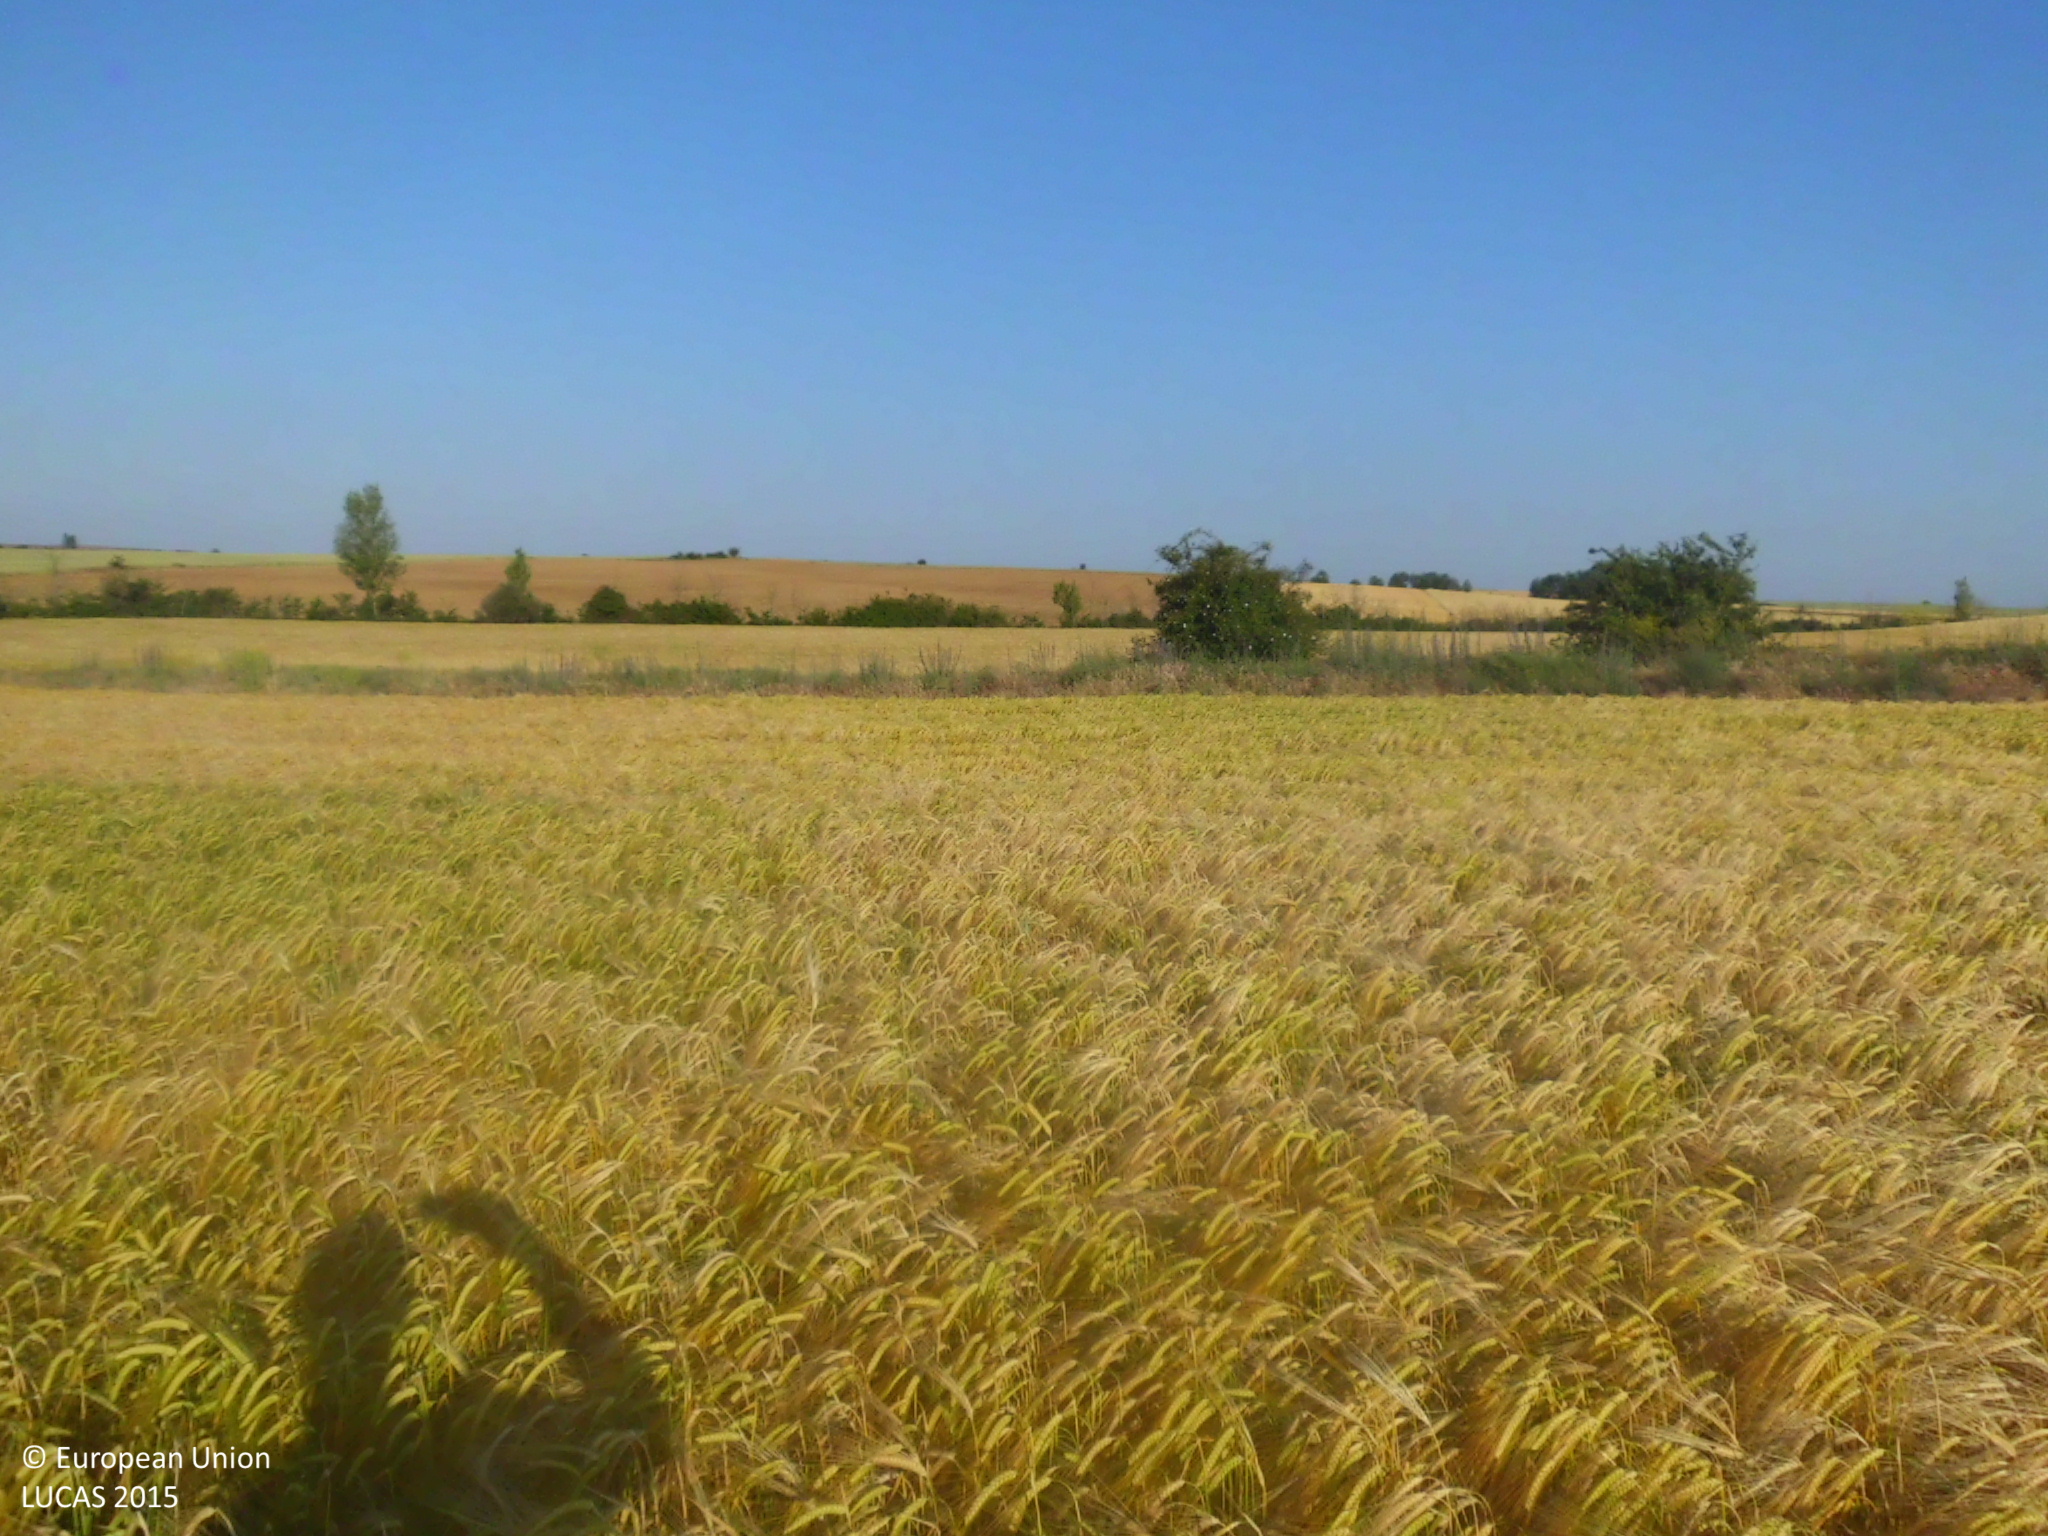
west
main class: Cropland
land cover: Barley
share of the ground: > 75 %
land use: Agriculture (excluding fallow land and kitchen gardens)
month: June
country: ES
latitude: 42.4577
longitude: -4.0393
